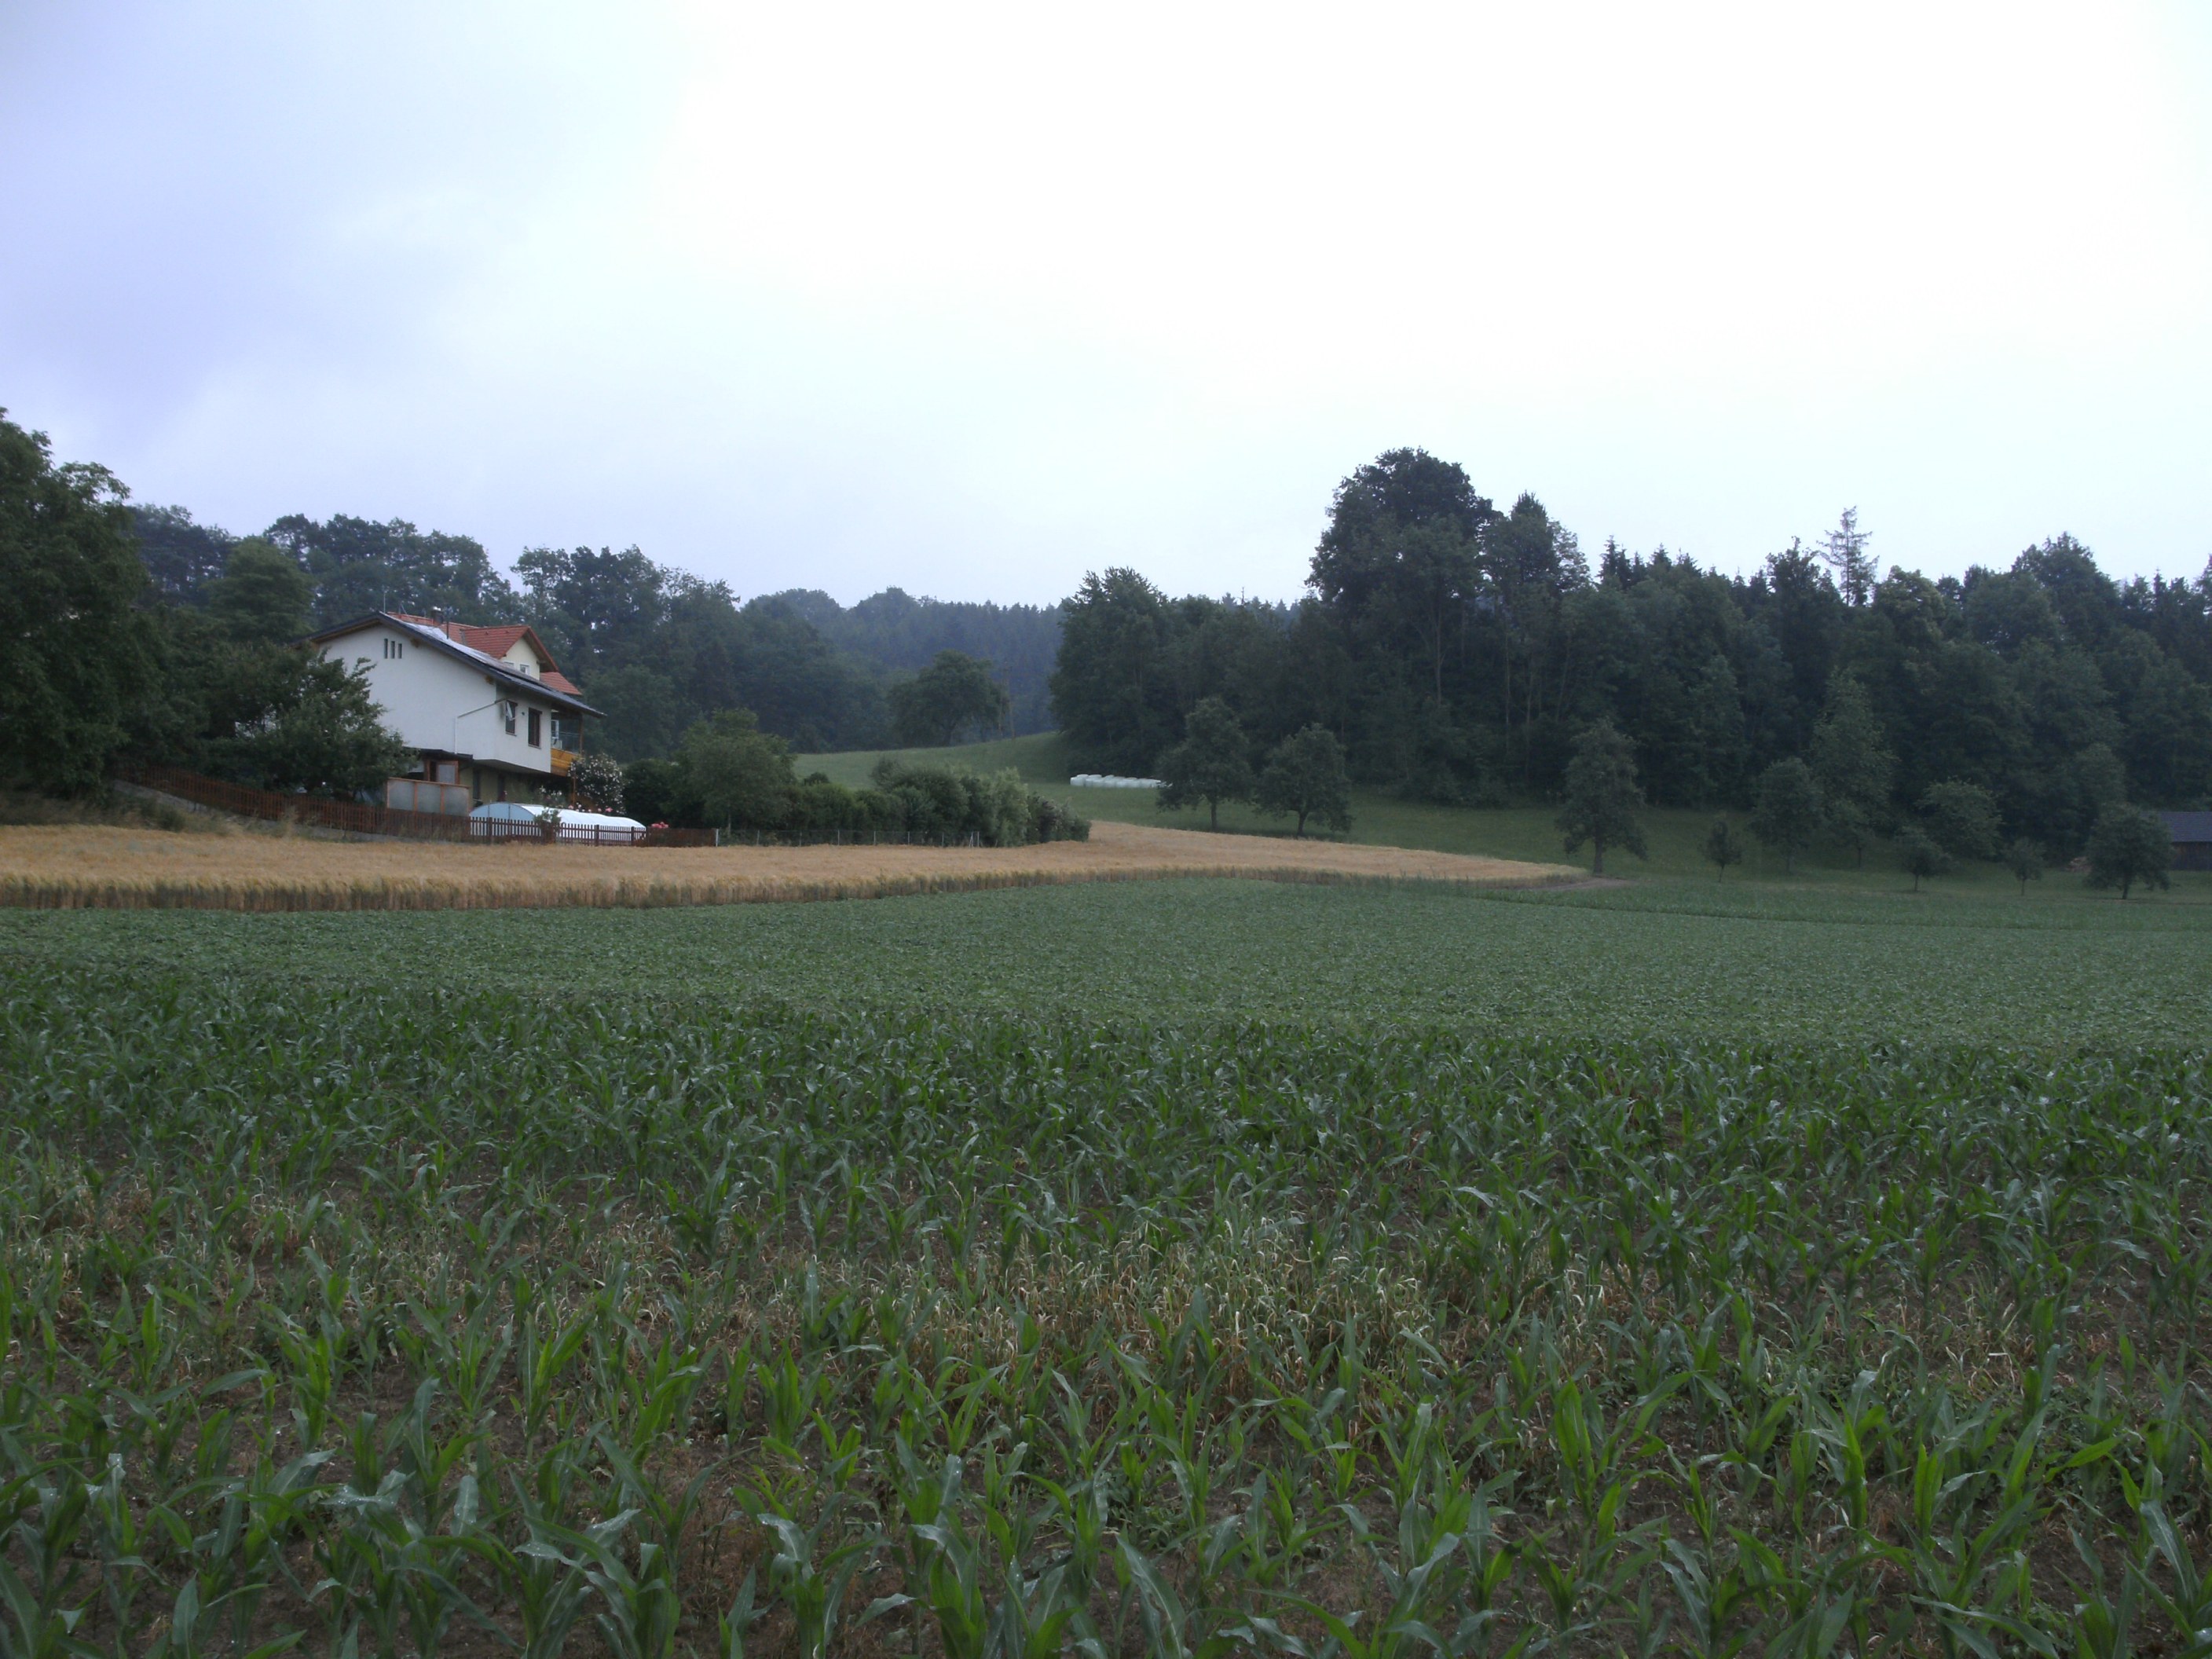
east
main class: Cropland
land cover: Maize
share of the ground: 25 - 50 %
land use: Agriculture (excluding fallow land and kitchen gardens)
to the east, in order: Maize; Soya; Barley; Shrubland without tree cover; Barley; Paved roads, cycling and walking lanes; Grassland without tree/shrub cover; Broadleaved woodland
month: June
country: AT
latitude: 48.3449
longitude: 14.1152
